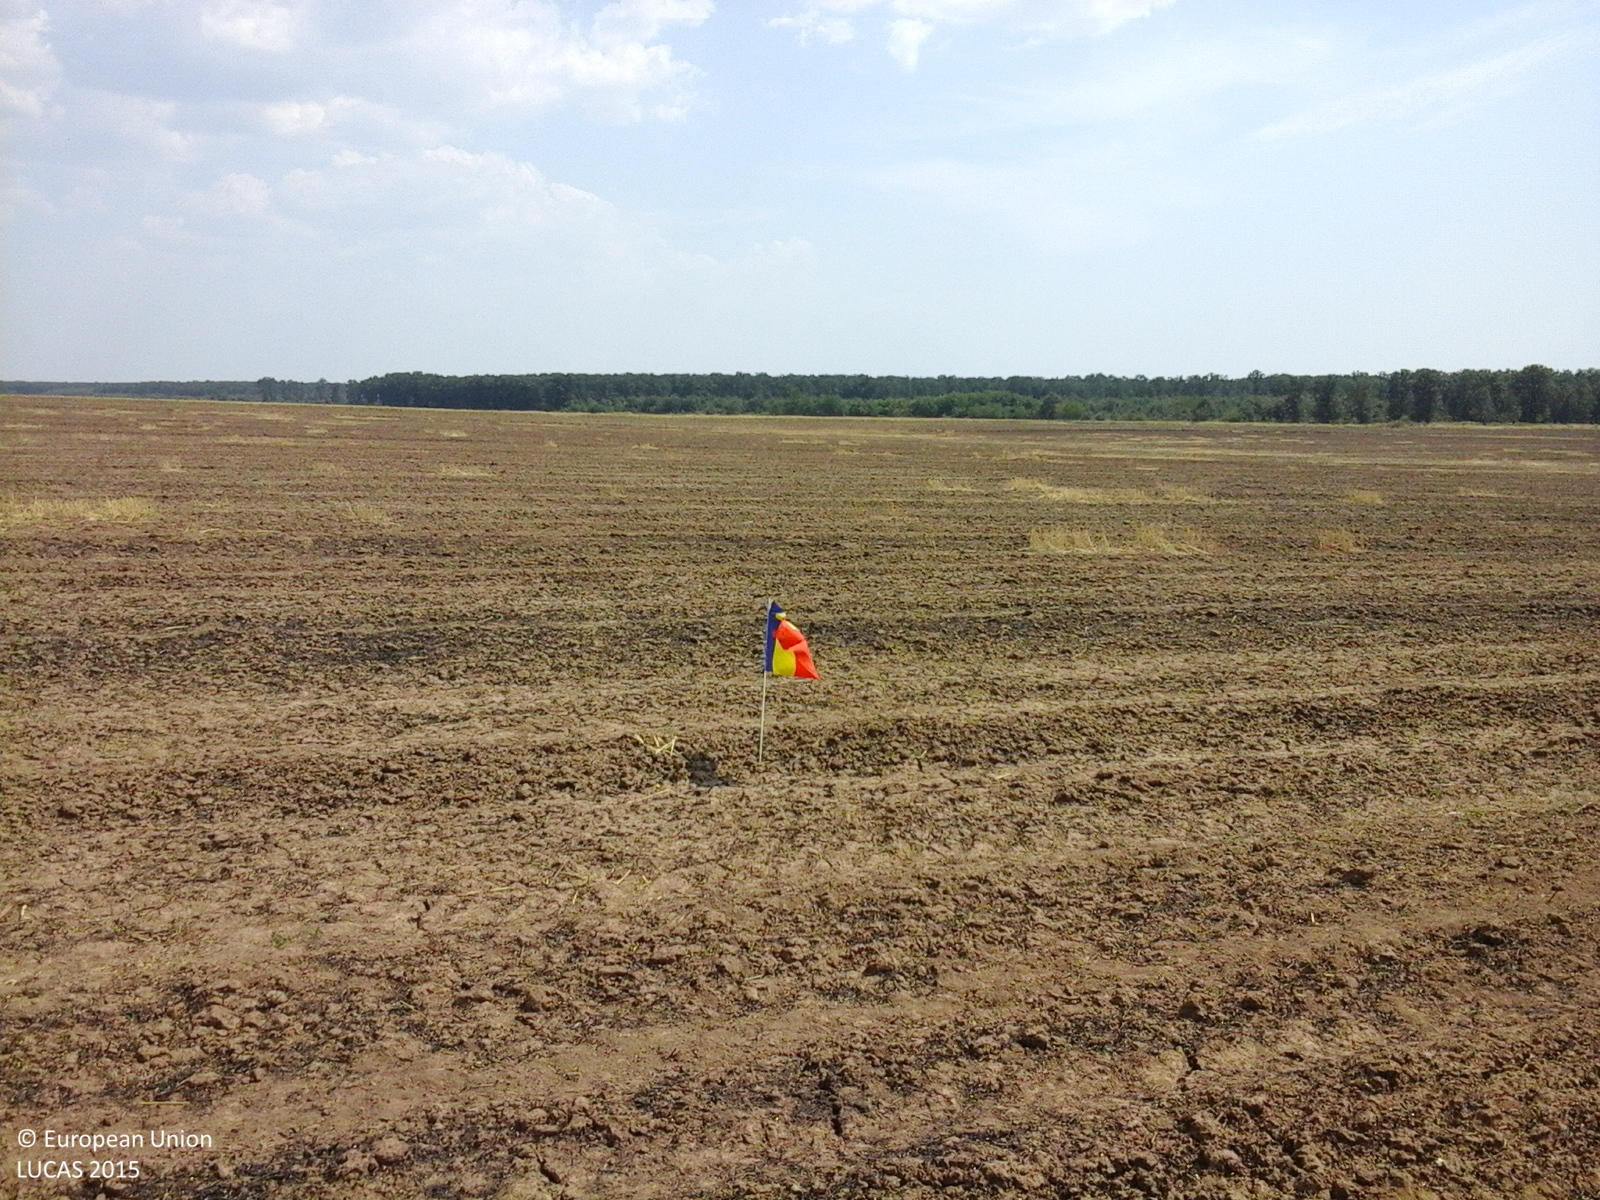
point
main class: Cropland
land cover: Common wheat
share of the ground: < 10 %
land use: Agriculture (excluding fallow land and kitchen gardens)
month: August
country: RO
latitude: 44.2599
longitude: 23.1349
